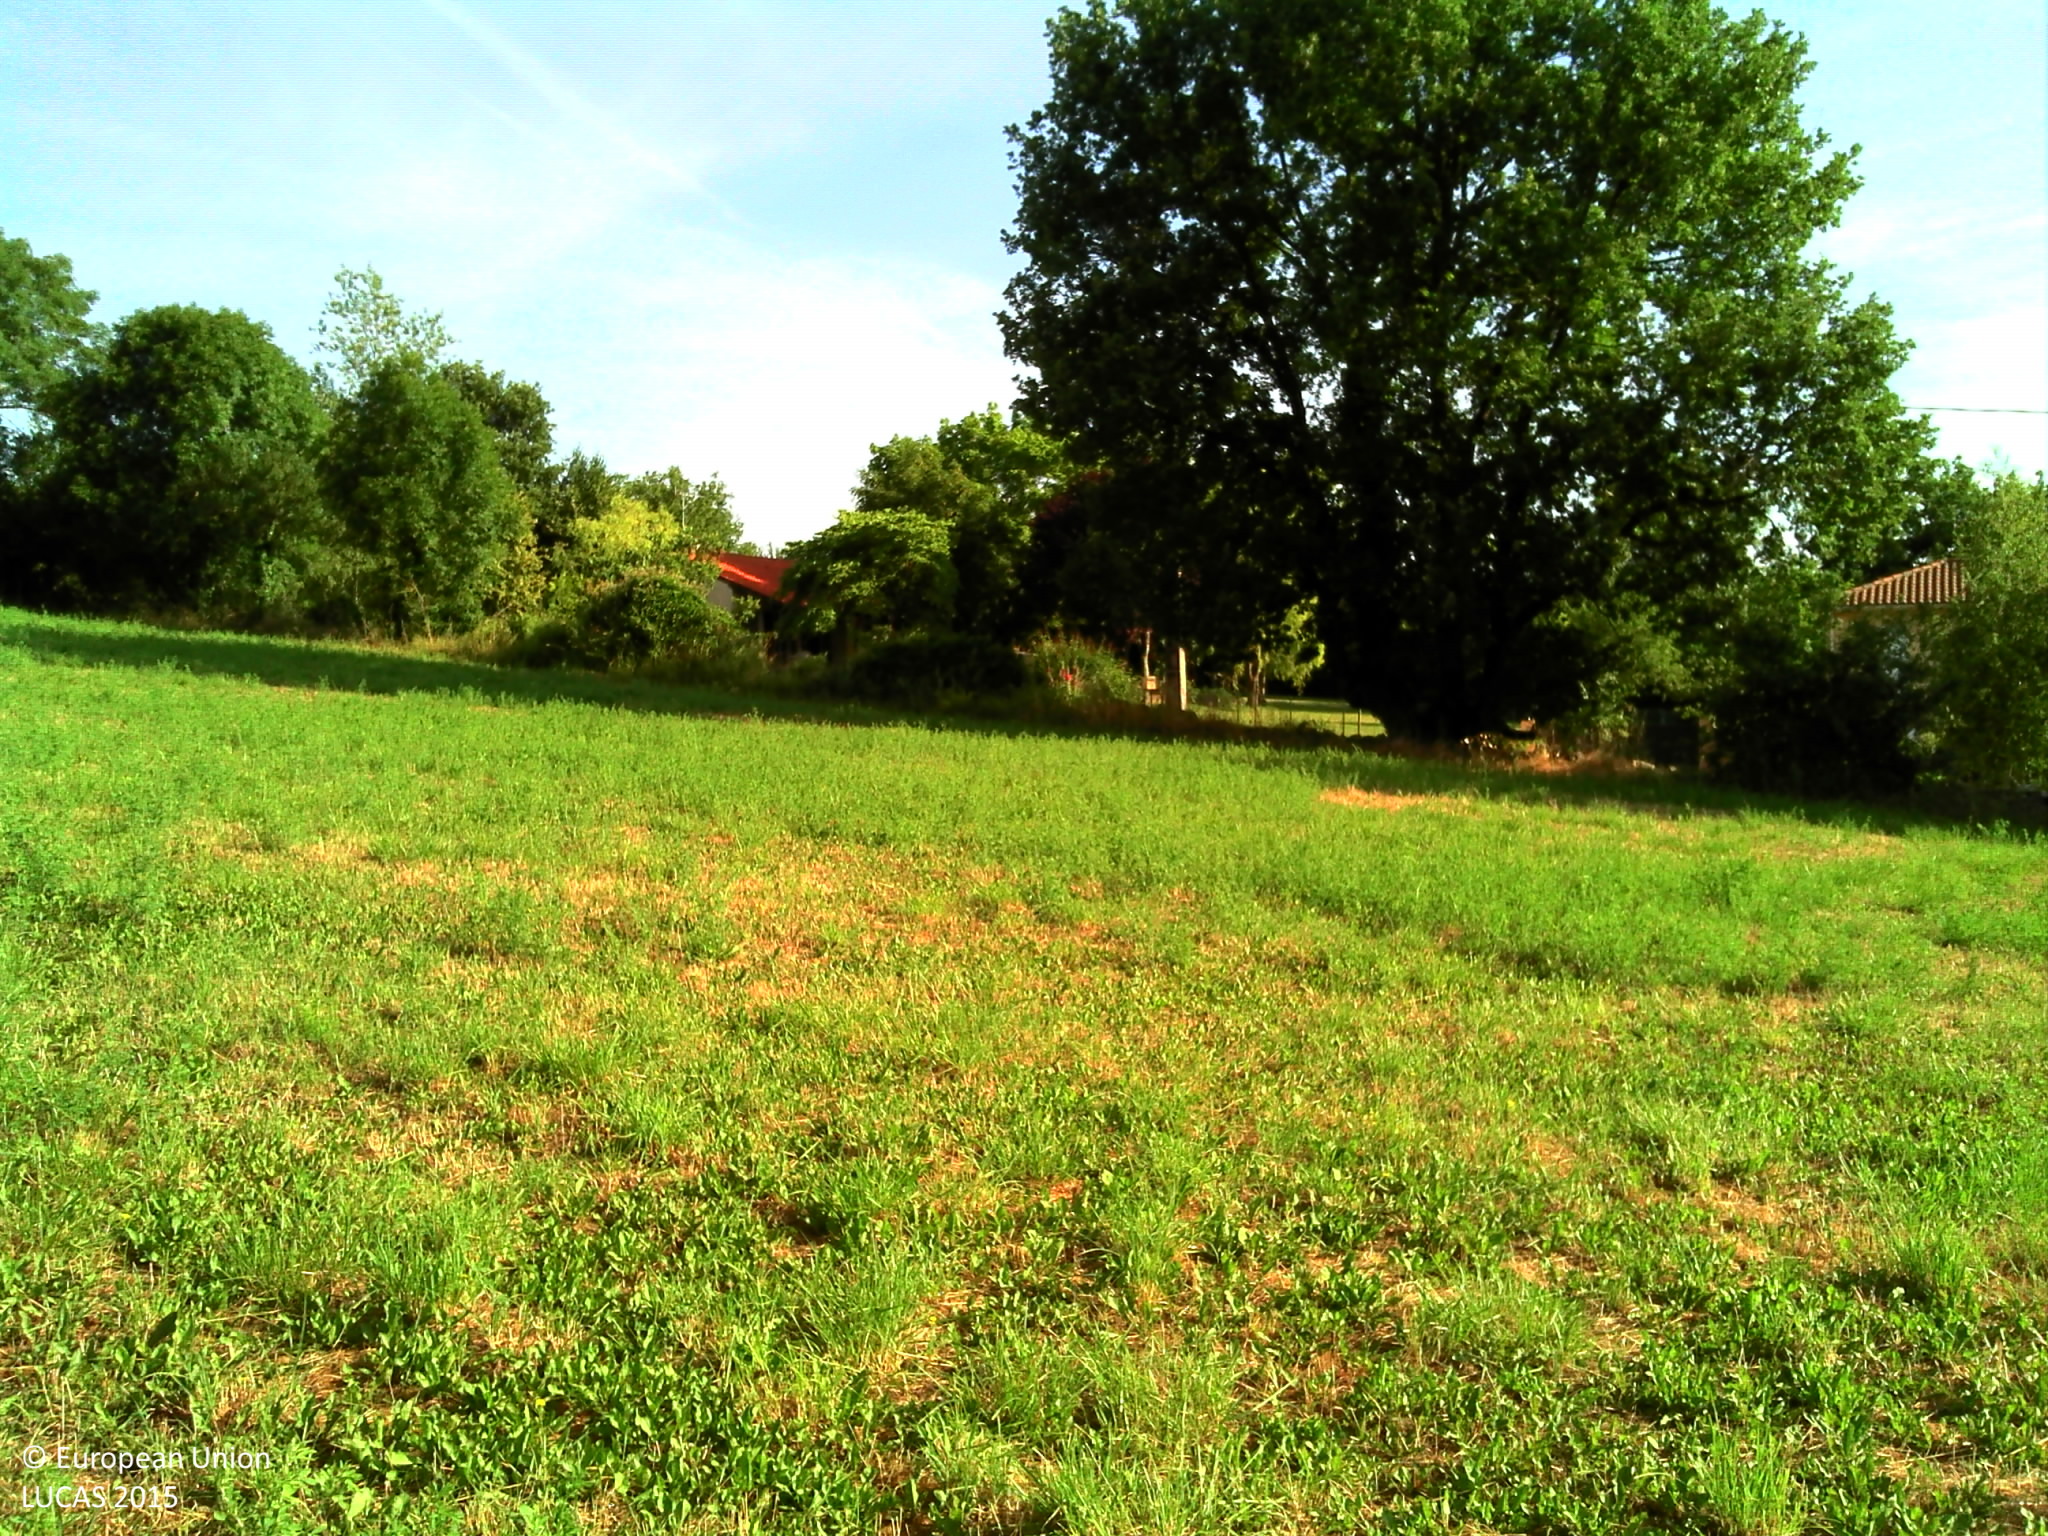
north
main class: Cropland
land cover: Lucerne
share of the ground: 50 - 75 %
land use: Agriculture (excluding fallow land and kitchen gardens)
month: June
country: FR
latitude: 44.4058
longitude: 2.0276
